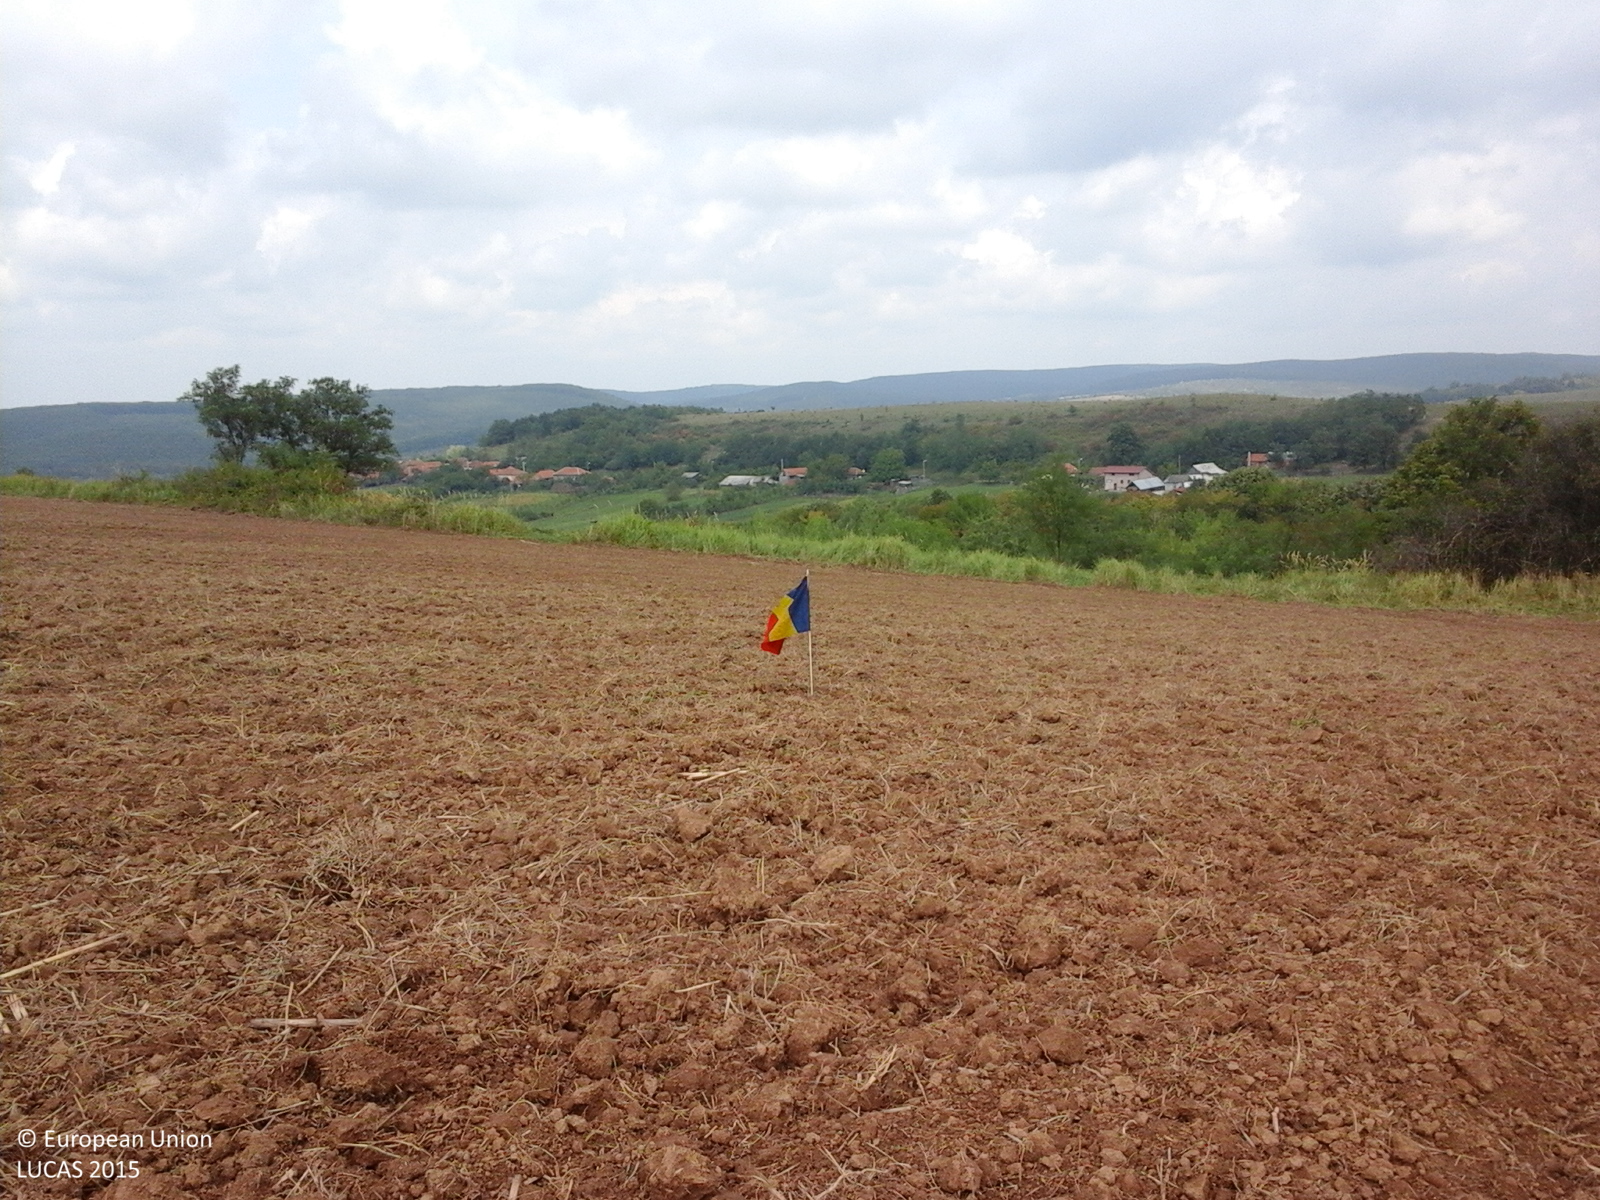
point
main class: Cropland
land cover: Maize
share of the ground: < 10 %
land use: Agriculture (excluding fallow land and kitchen gardens)
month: September
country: RO
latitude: 46.8770
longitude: 21.9731
